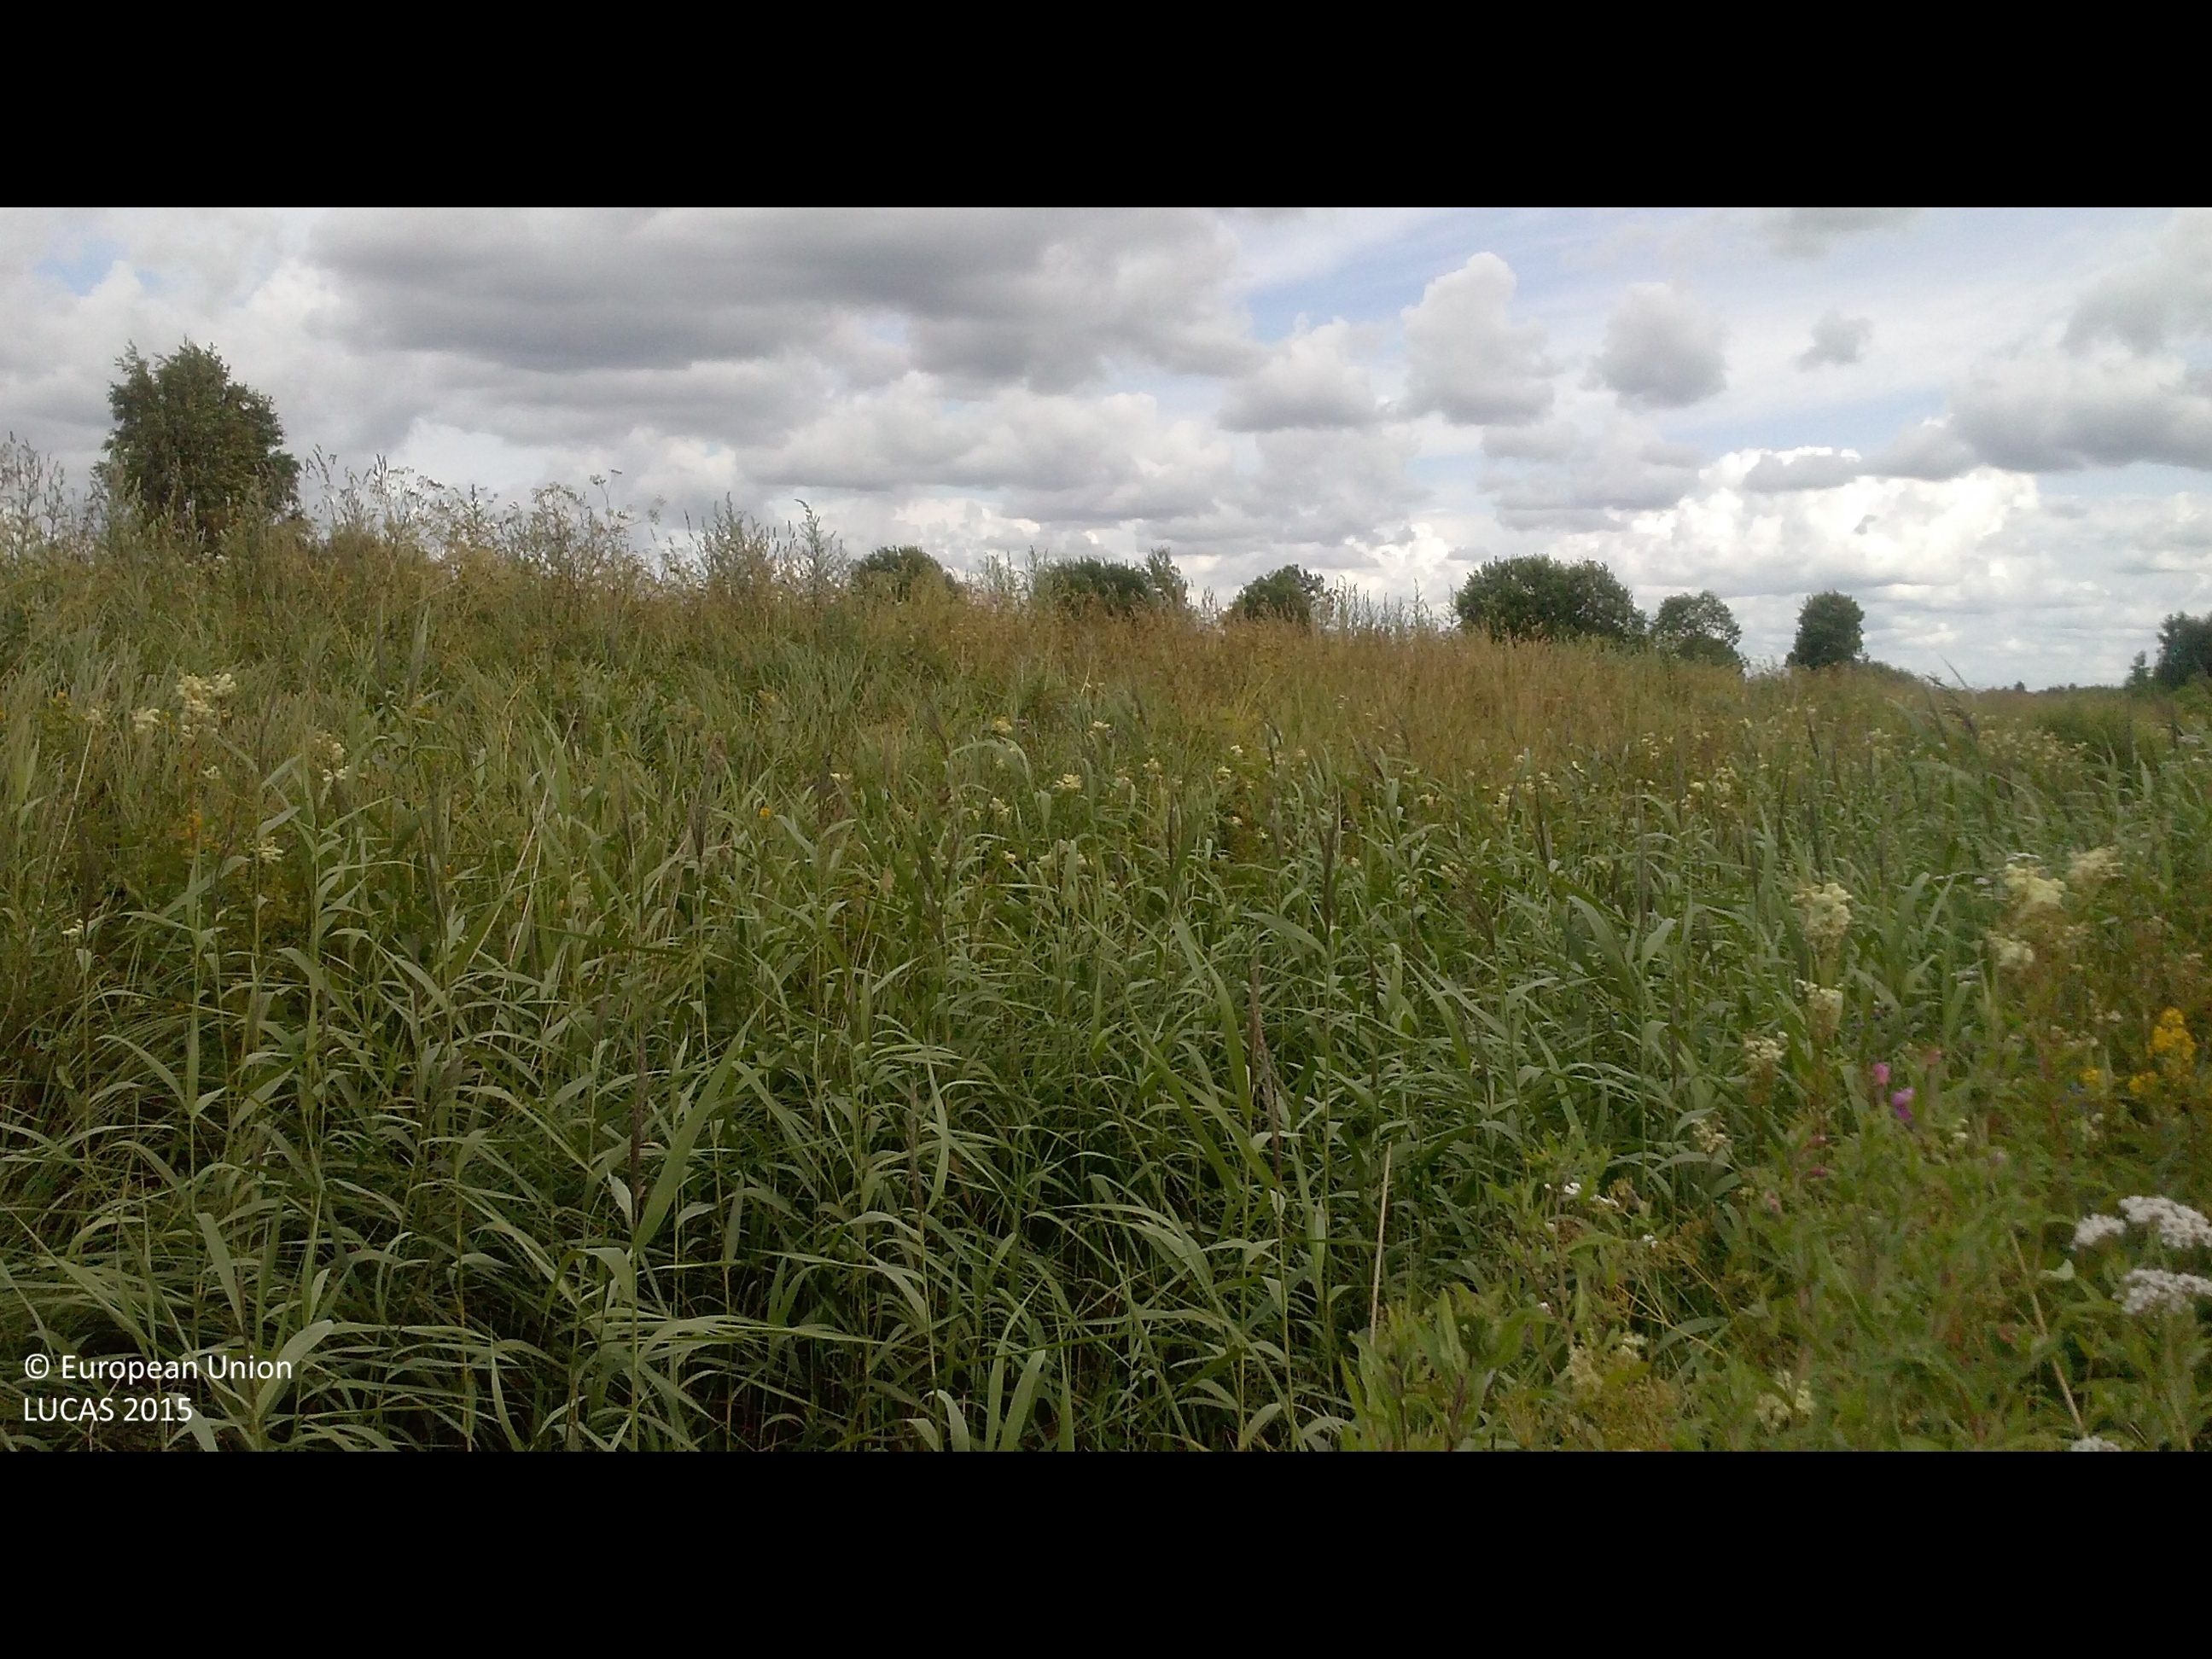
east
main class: Grassland
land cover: Spontaneously vegetated surfaces
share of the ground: > 75 %
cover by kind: herbaceous plants 100 %
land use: Semi-natural and natural areas not in use
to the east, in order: Spontaneously vegetated surfaces; Rye; Grassland with sparse tree/shrub cover; Rye
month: July
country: LV
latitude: 56.4434
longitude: 26.9842
